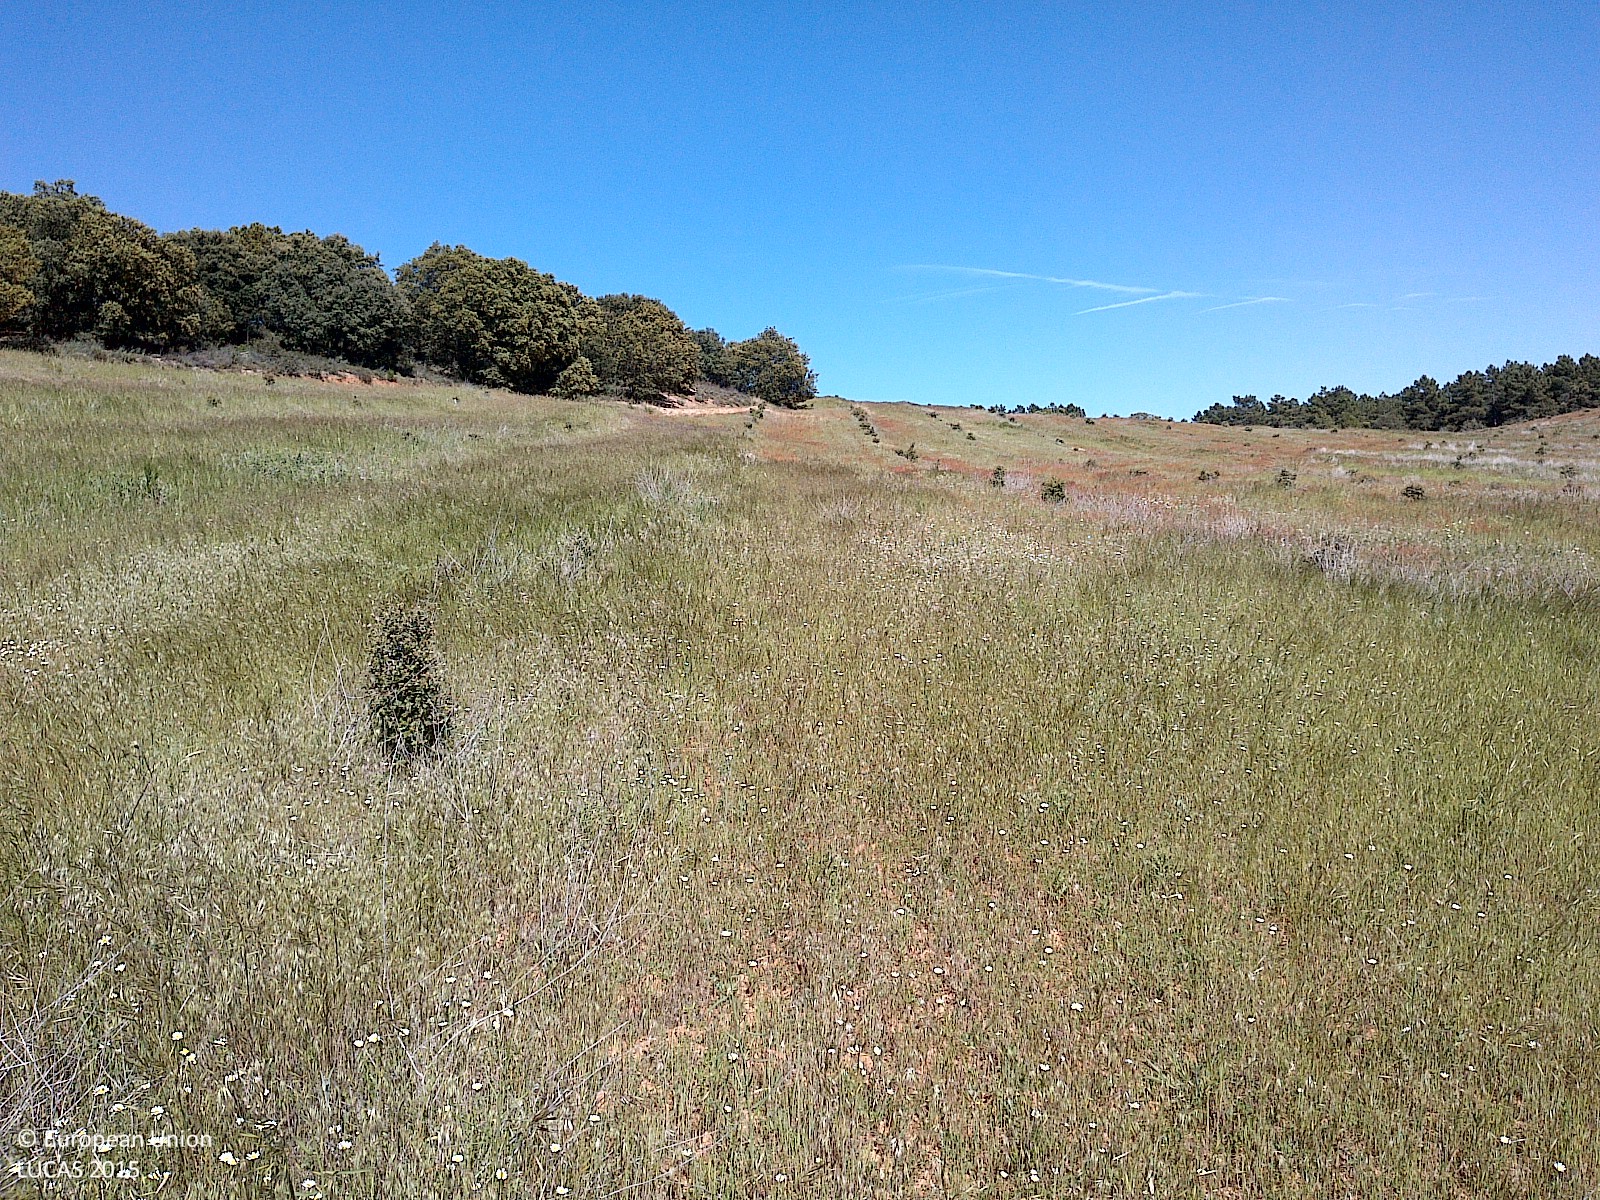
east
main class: Woodland
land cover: Broadleaved woodland
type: broadleaved evergreen forest
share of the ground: 10 - 25 %
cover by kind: herbaceous plants 85 %, broadleaved forest trees 10 %, unconsolidated bare surface 5 %
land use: Forestry
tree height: < 5 m
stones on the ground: < 10 %
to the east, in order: Broadleaved woodland; Spontaneously vegetated surfaces; Managed hedges; Fences; Tracks; Shruby margins; Pine dominated coniferous woodland
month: May
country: ES
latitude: 41.6293
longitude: -3.1404
